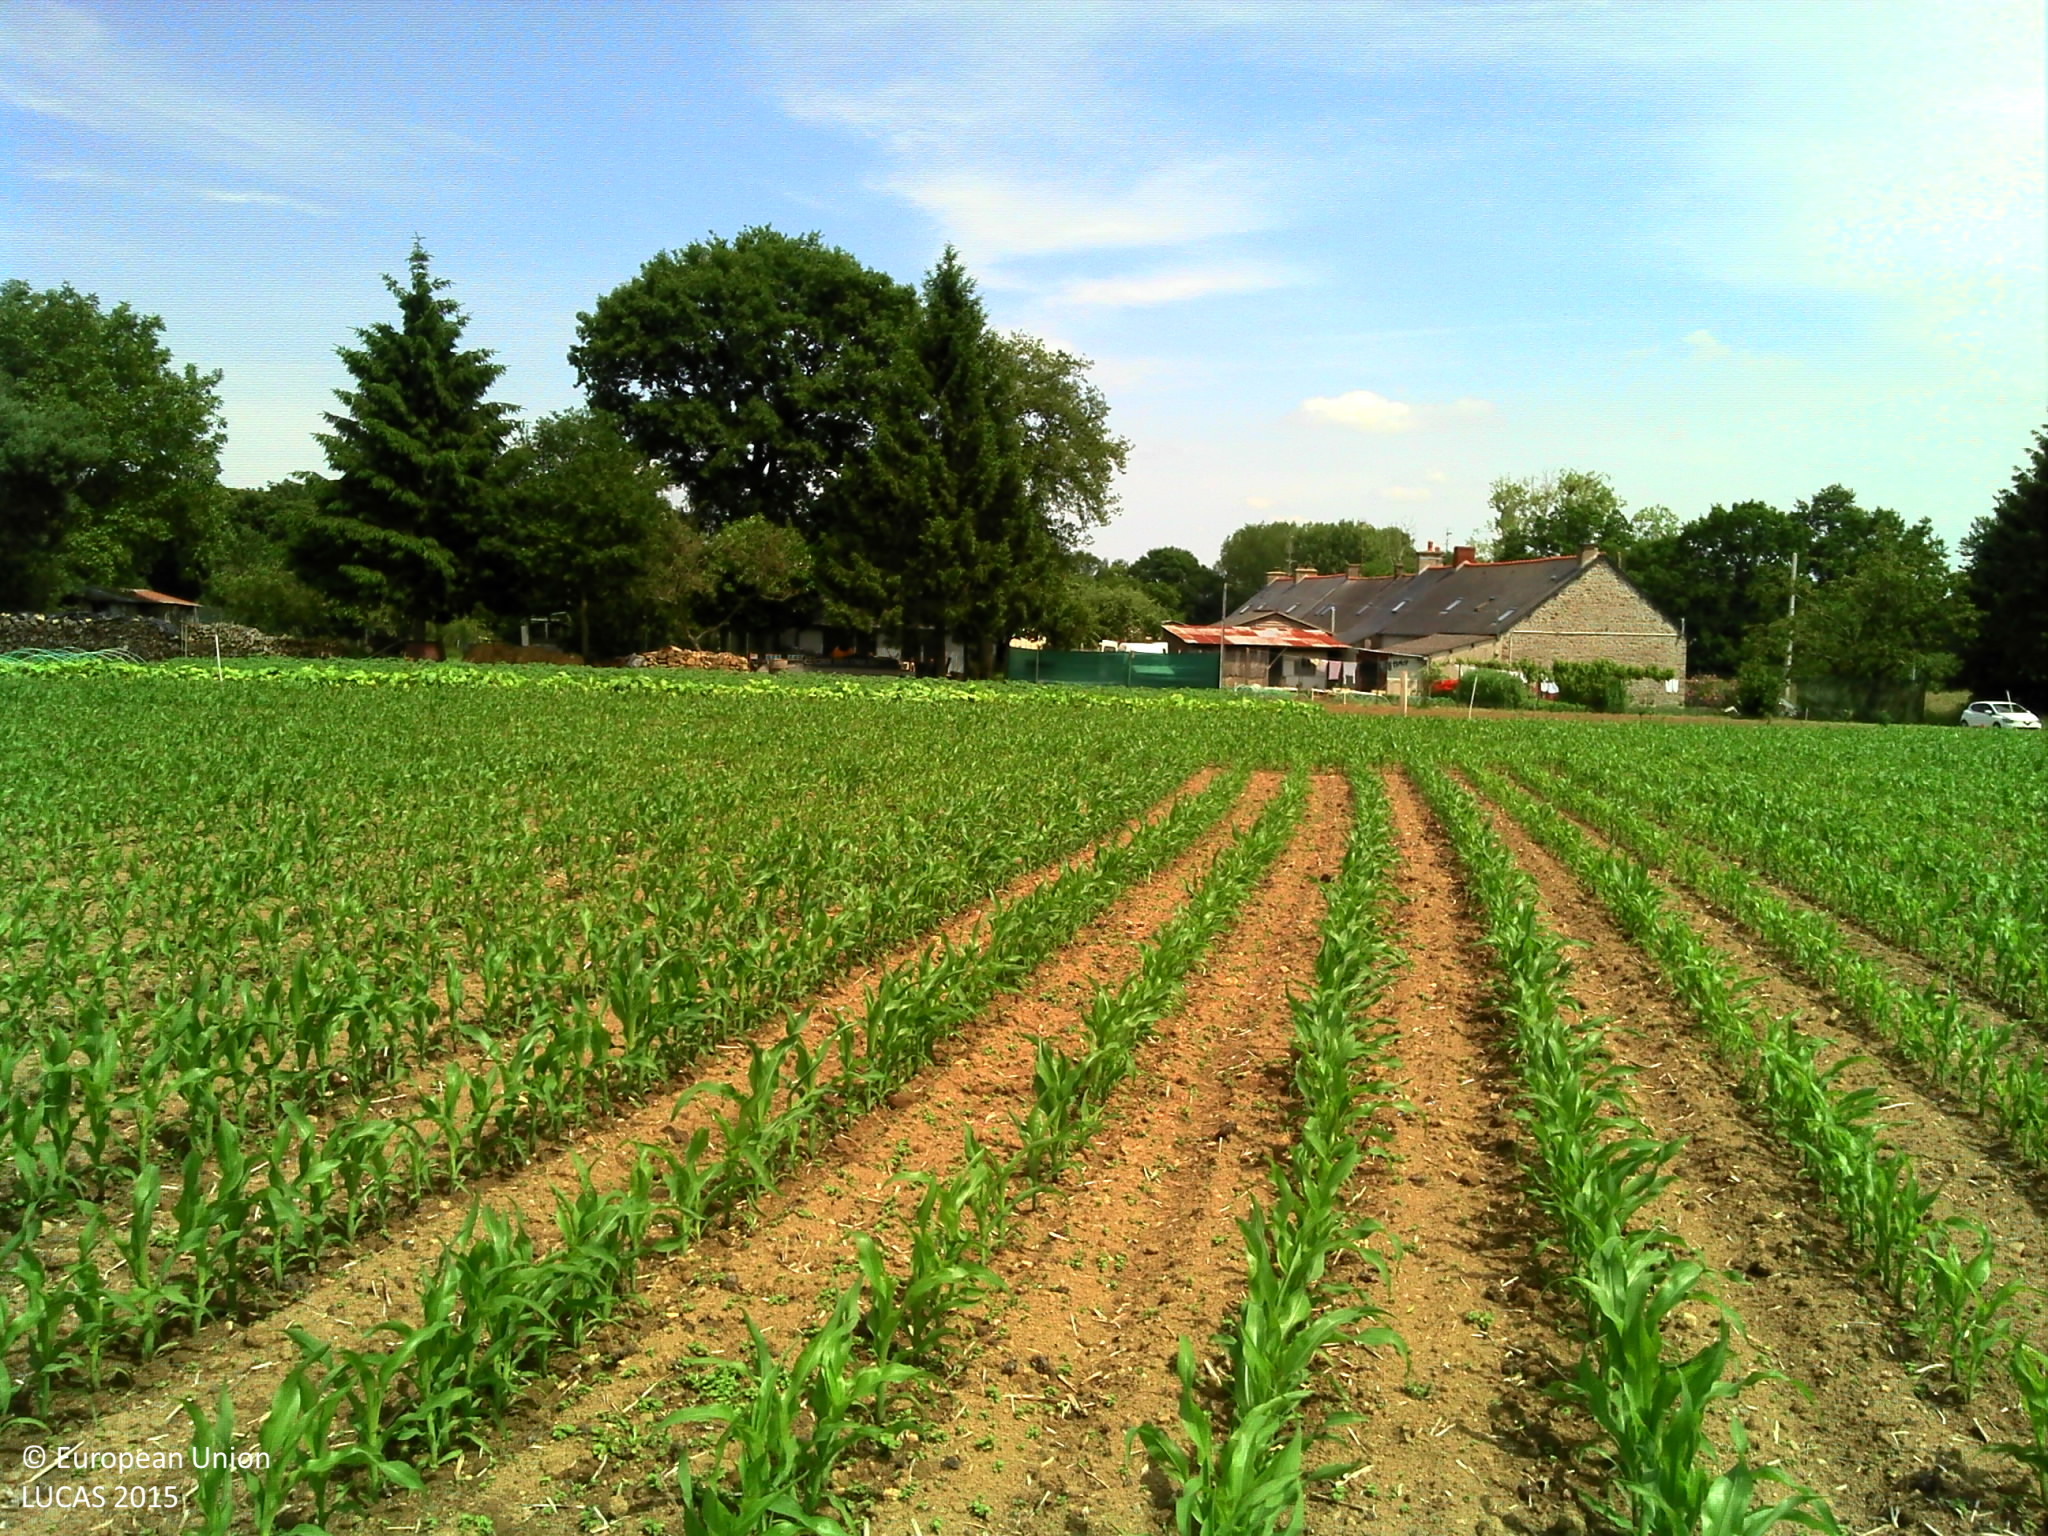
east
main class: Cropland
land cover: Maize
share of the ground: 25 - 50 %
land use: Agriculture (excluding fallow land and kitchen gardens)
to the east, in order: Maize; Other fresh vegetables; Lines of trees; Artificial constructions in urban areas; Spontaneously vegetated surfaces; Artificial constructions in urban areas
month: June
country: FR
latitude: 48.3257
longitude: -1.5247
